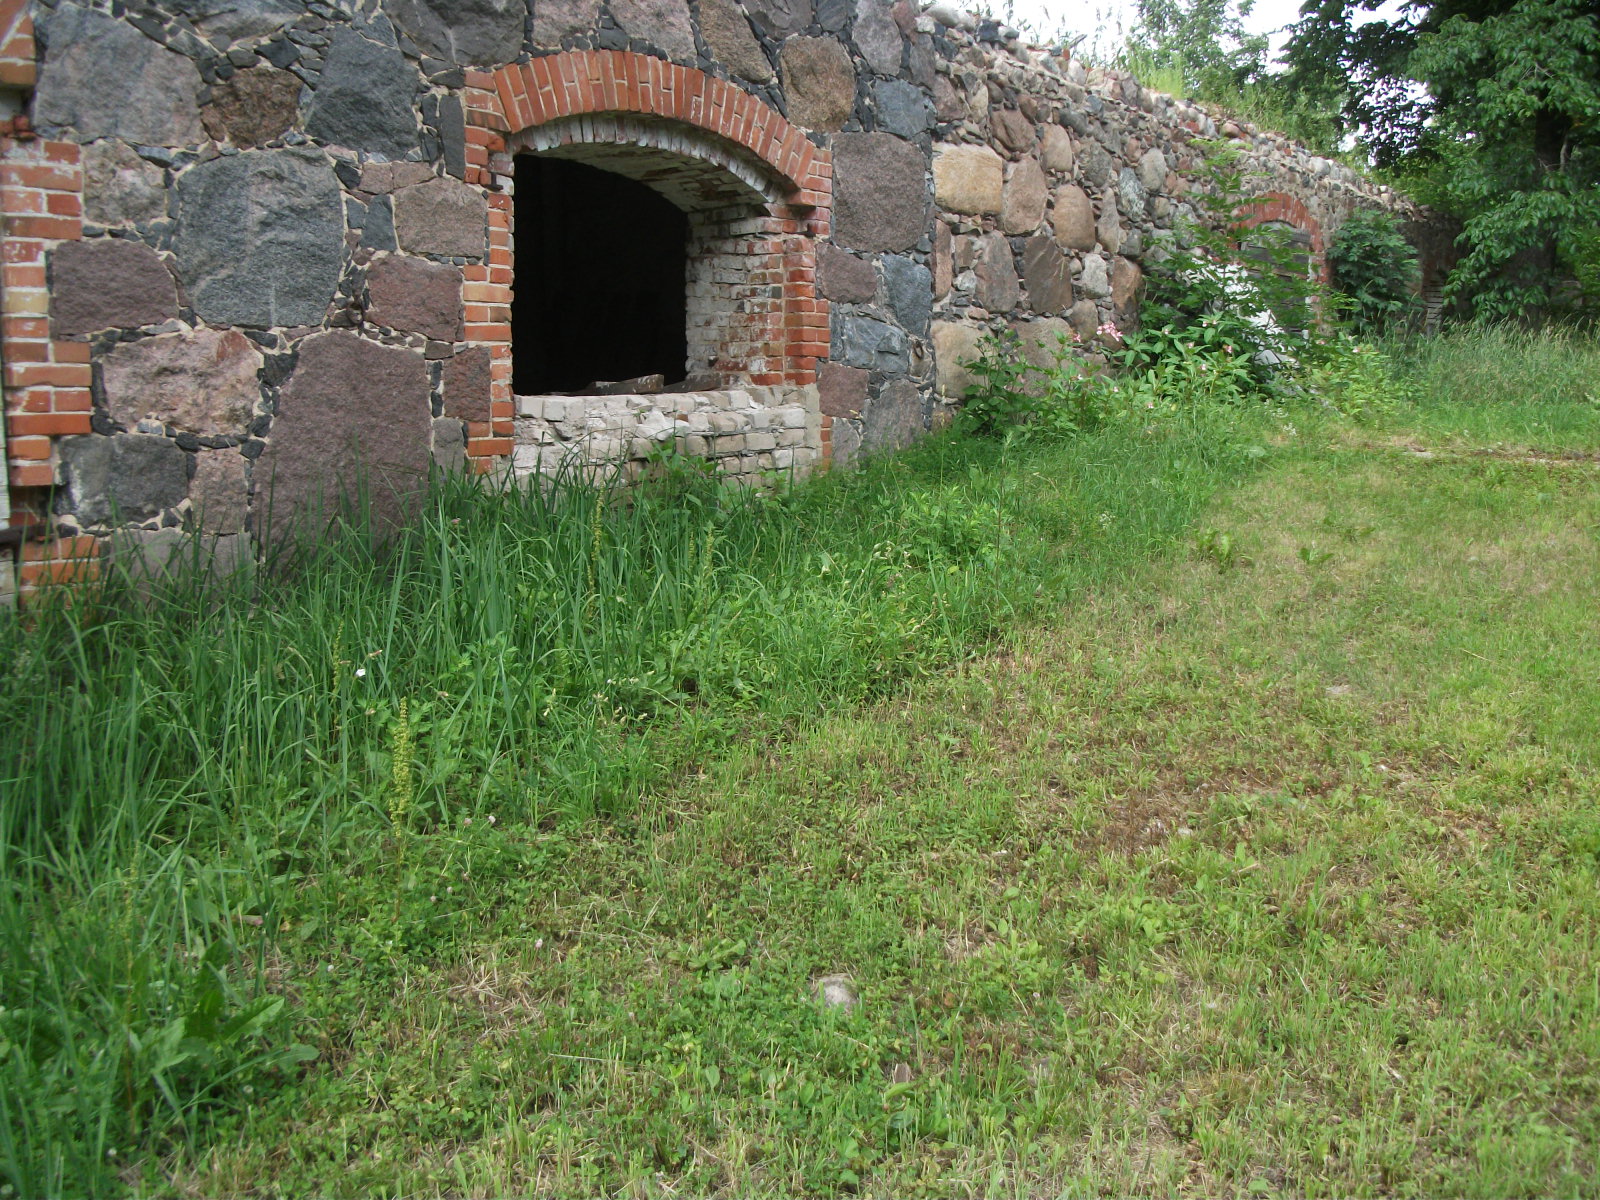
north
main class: Grassland
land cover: Grassland without tree/shrub cover
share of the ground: > 75 %
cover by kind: herbaceous plants 100 %
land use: Residential
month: July
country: LV
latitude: 57.0121
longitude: 26.2944
